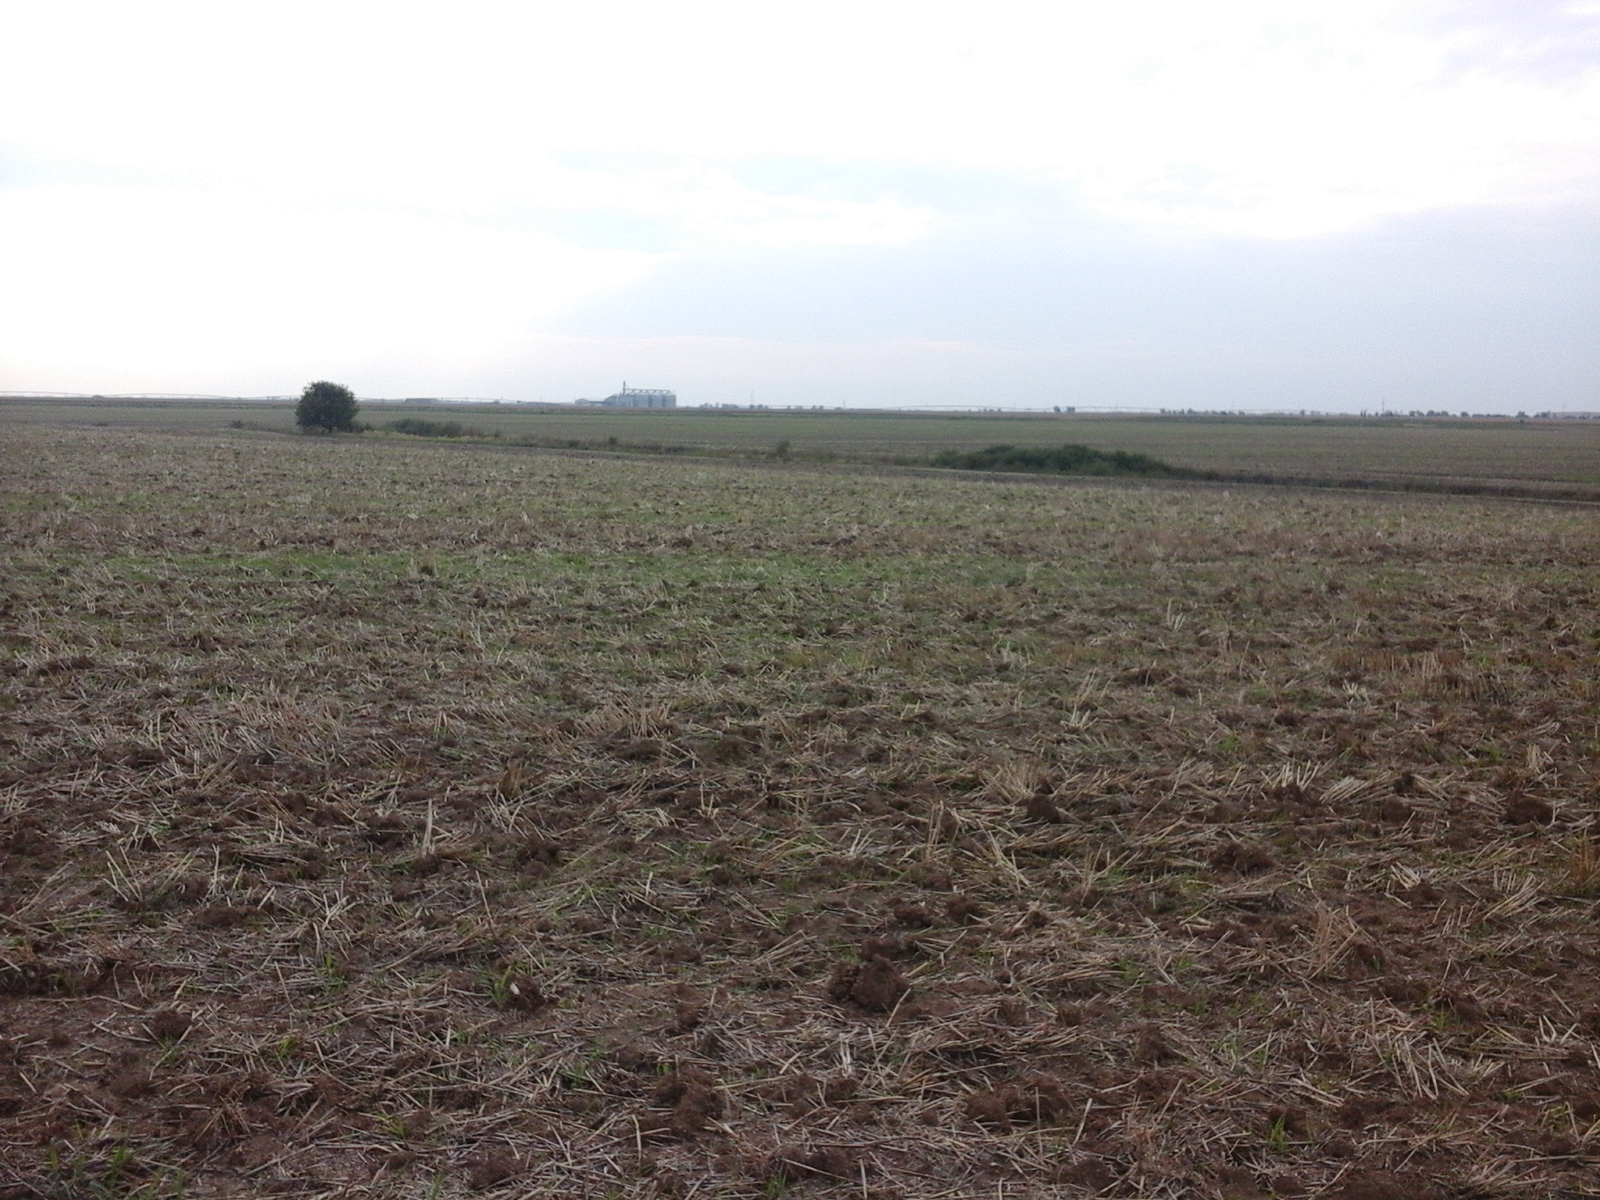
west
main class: Cropland
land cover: Common wheat
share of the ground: < 10 %
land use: Agriculture (excluding fallow land and kitchen gardens)
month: August
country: RO
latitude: 46.2159
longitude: 21.5348
